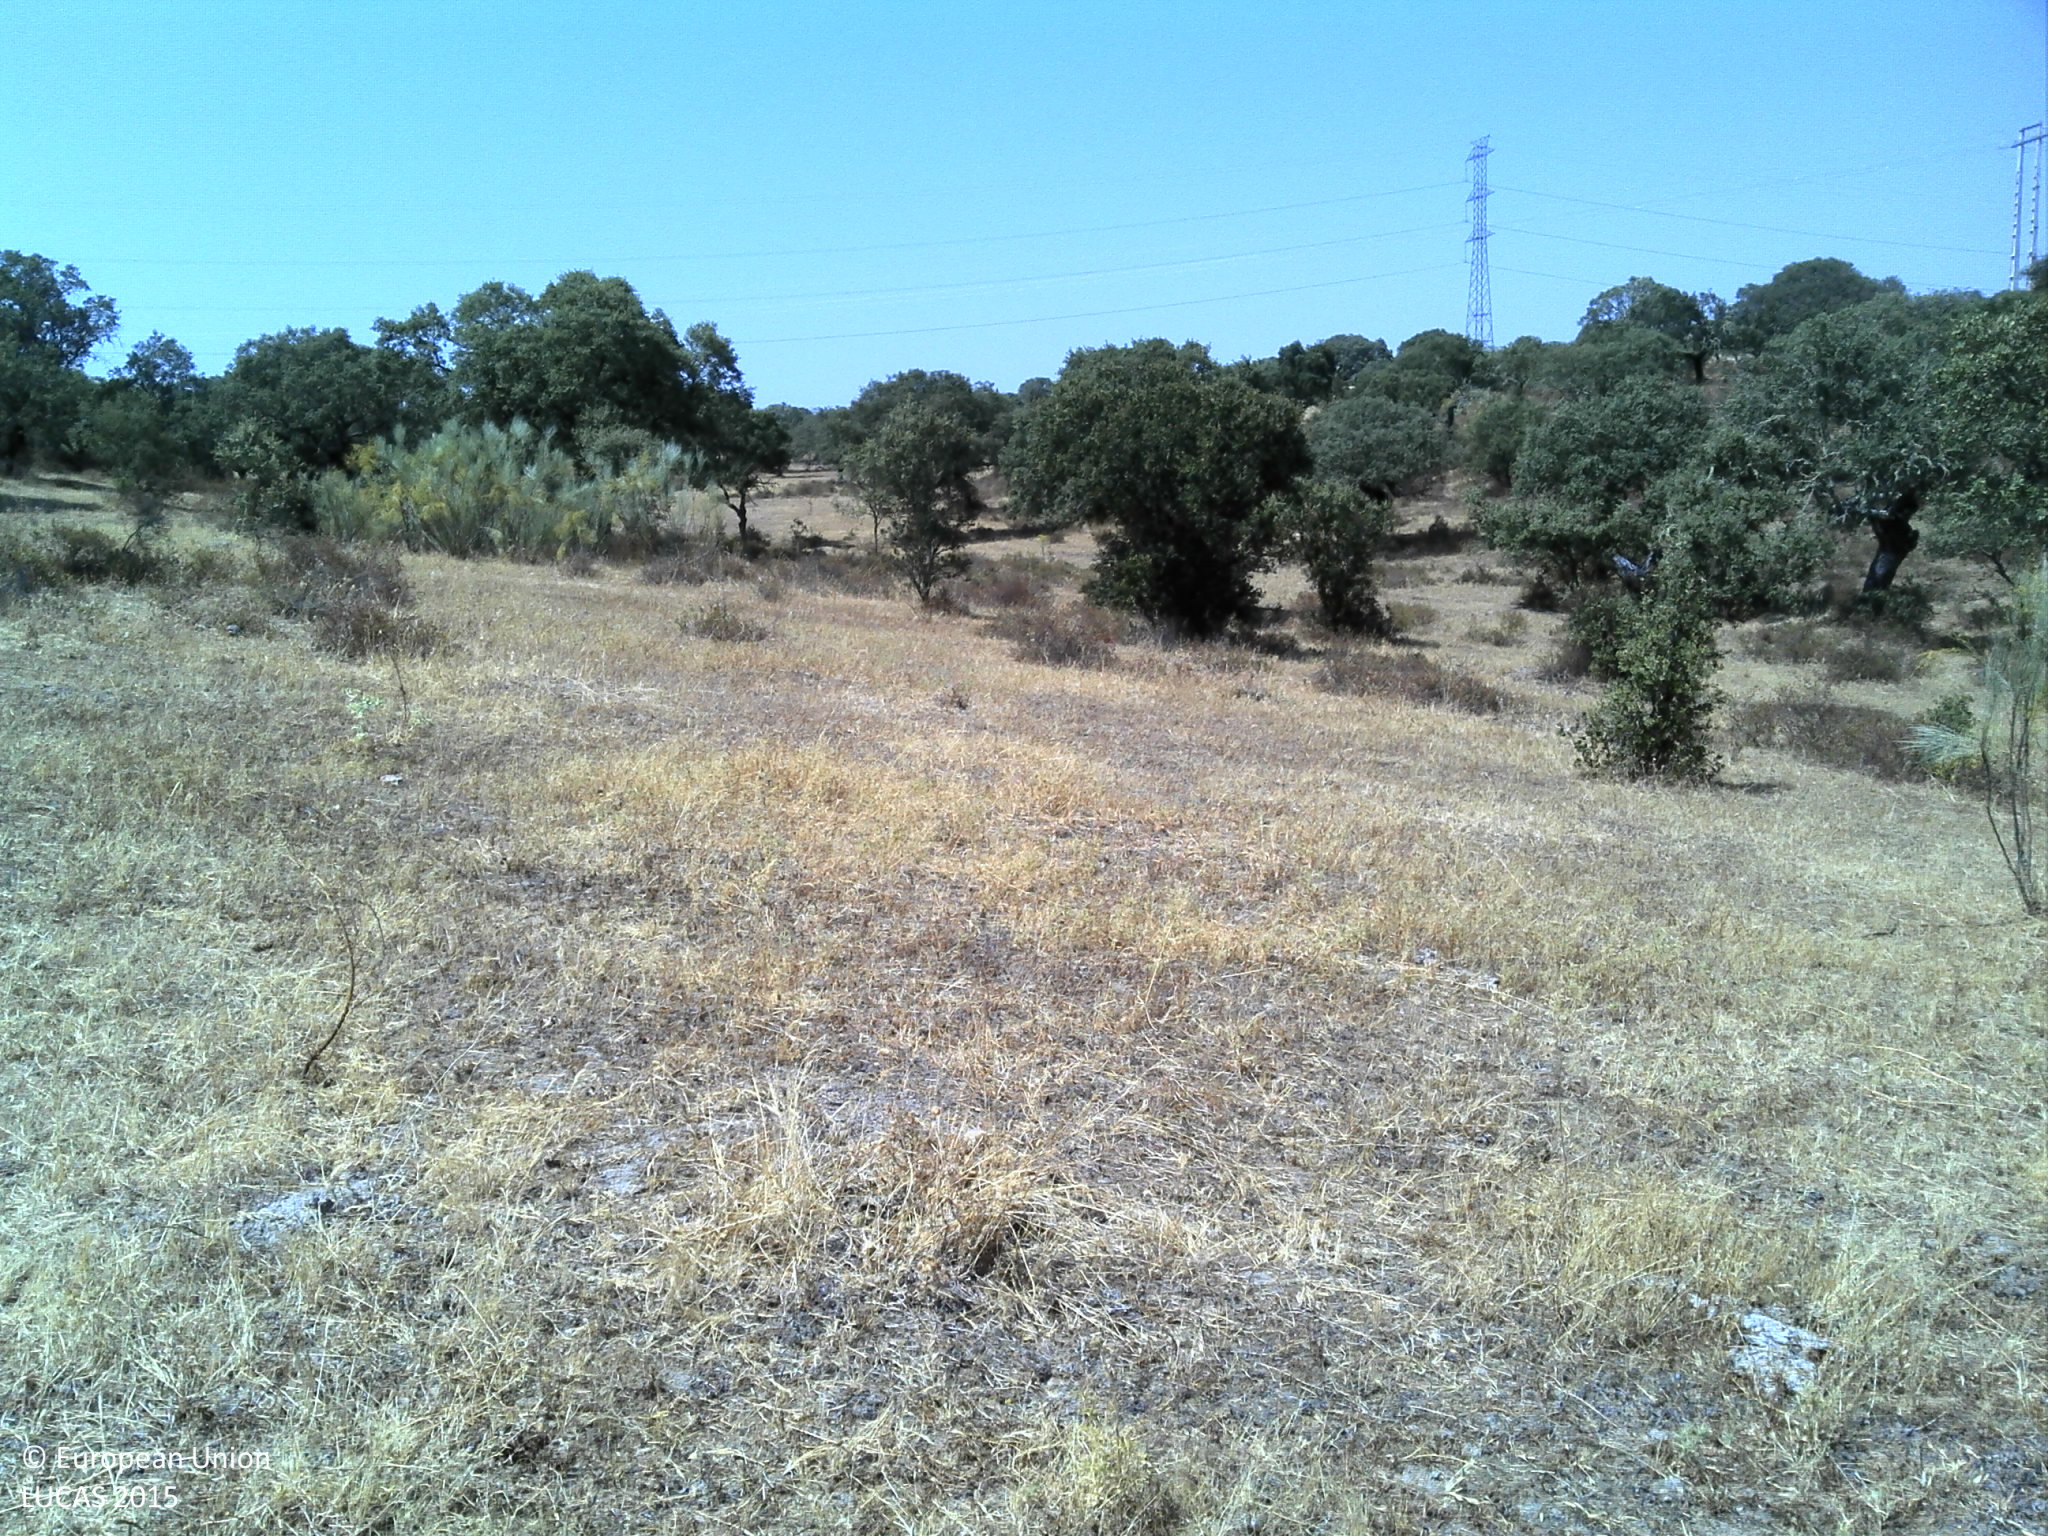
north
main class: Woodland
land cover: Broadleaved woodland
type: broadleaved evergreen forest
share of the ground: 10 - 25 %
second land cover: Grassland without tree/shrub cover
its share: 10 - 25 %
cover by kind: unconsolidated bare surface 55 %, broadleaved forest trees 25 %, herbaceous plants 20 %
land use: Forestry
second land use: Agriculture (excluding fallow land and kitchen gardens)
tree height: > 5 m
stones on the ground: < 10 %
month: June
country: PT
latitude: 38.2187
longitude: -7.3004
